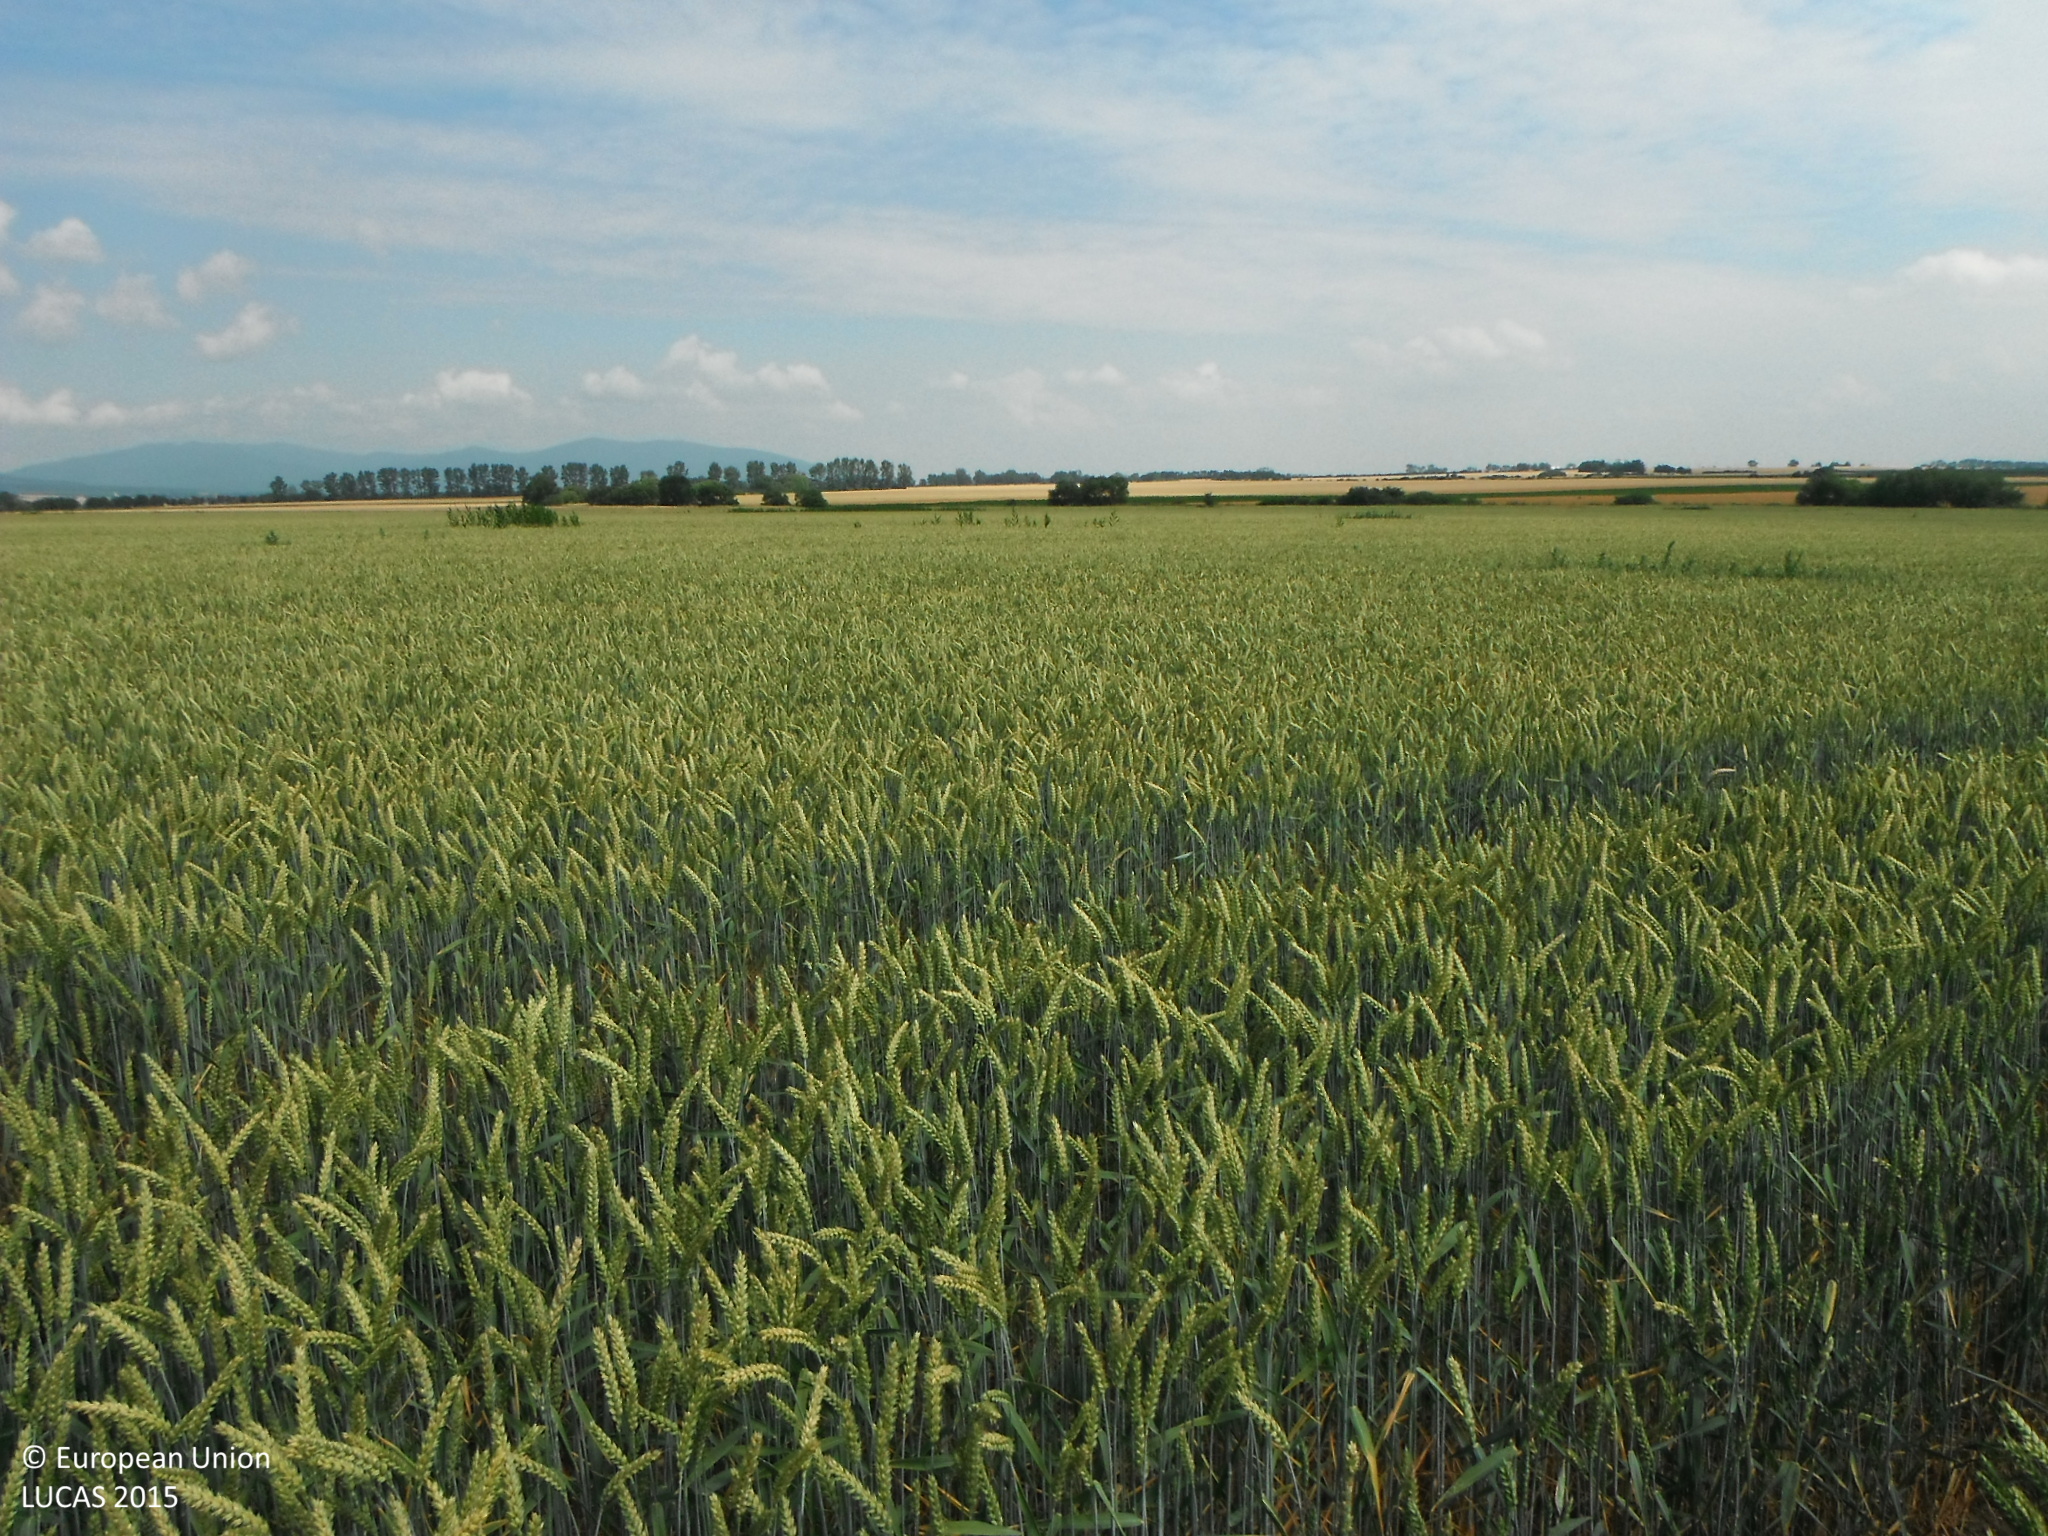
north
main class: Cropland
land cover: Common wheat
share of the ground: > 75 %
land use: Agriculture (excluding fallow land and kitchen gardens)
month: June
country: SK
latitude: 48.6393
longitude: 21.6527
